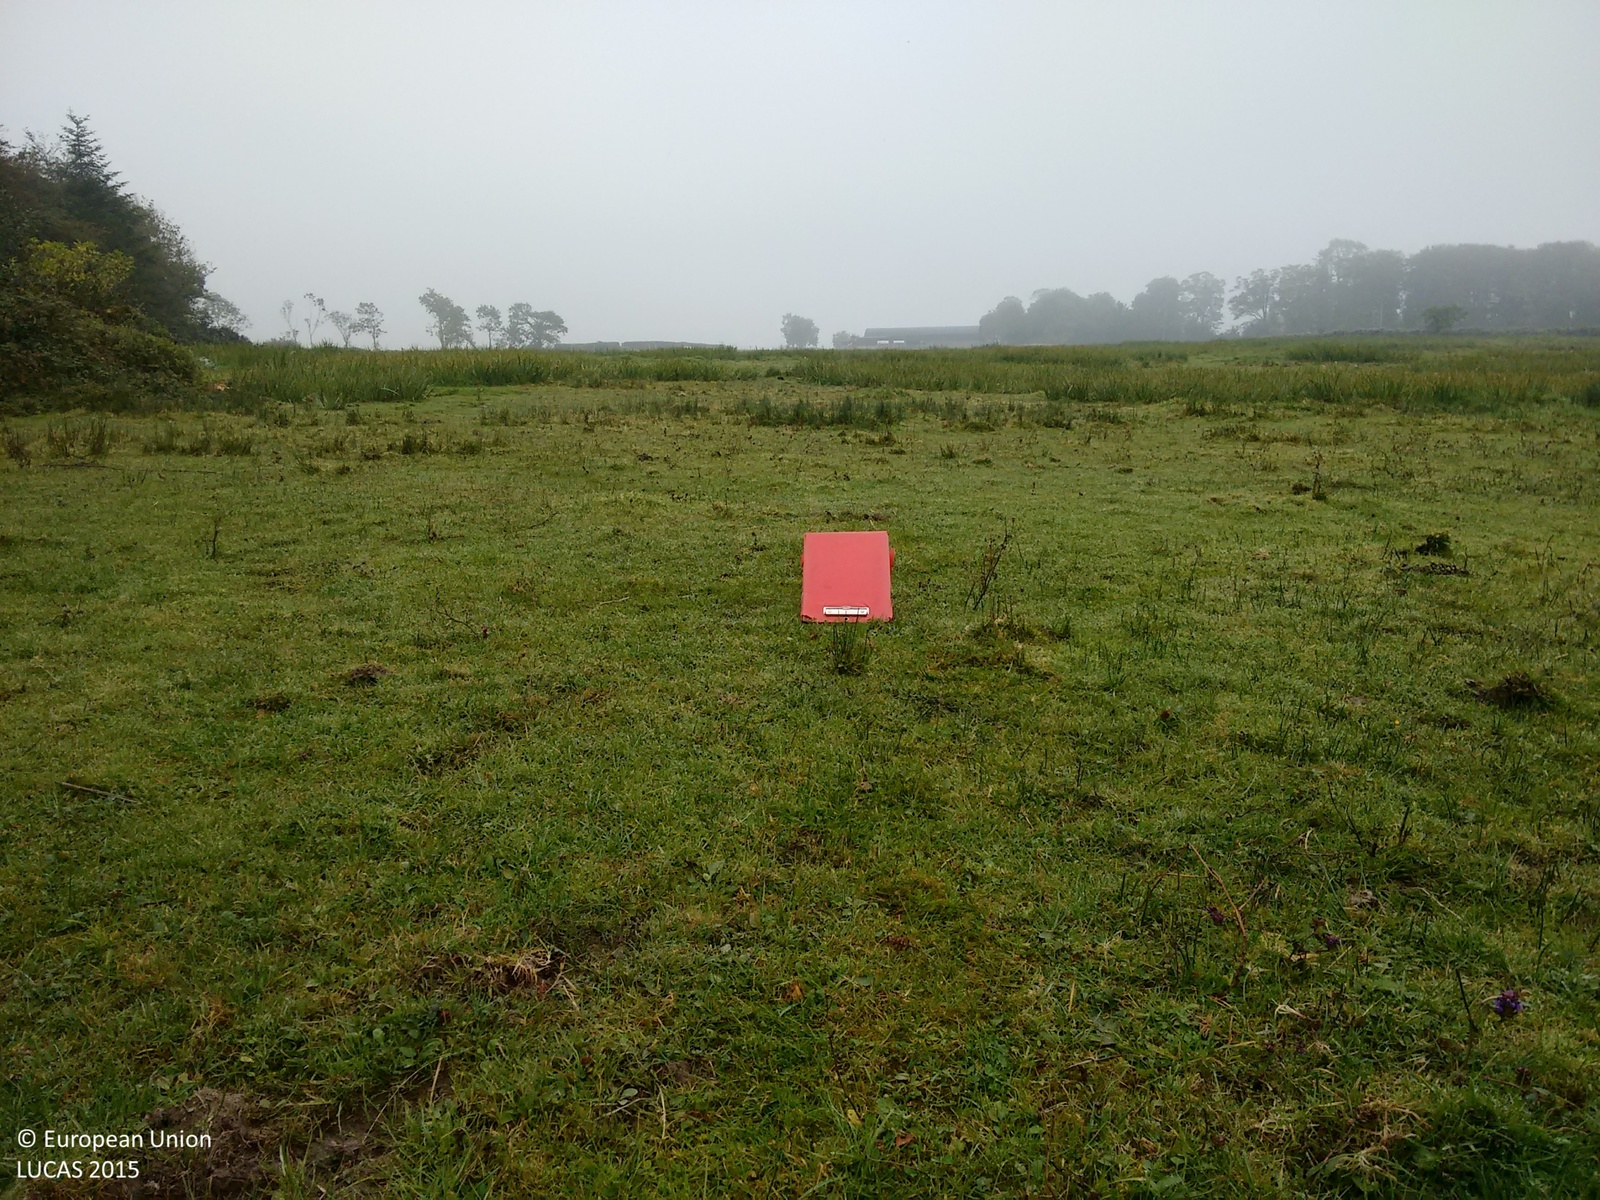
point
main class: Grassland
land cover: Grassland without tree/shrub cover
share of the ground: > 75 %
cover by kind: herbaceous plants 75 %, shrubs 5 %
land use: Agriculture (excluding fallow land and kitchen gardens)
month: October
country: IE
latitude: 52.4541
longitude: -8.9742
